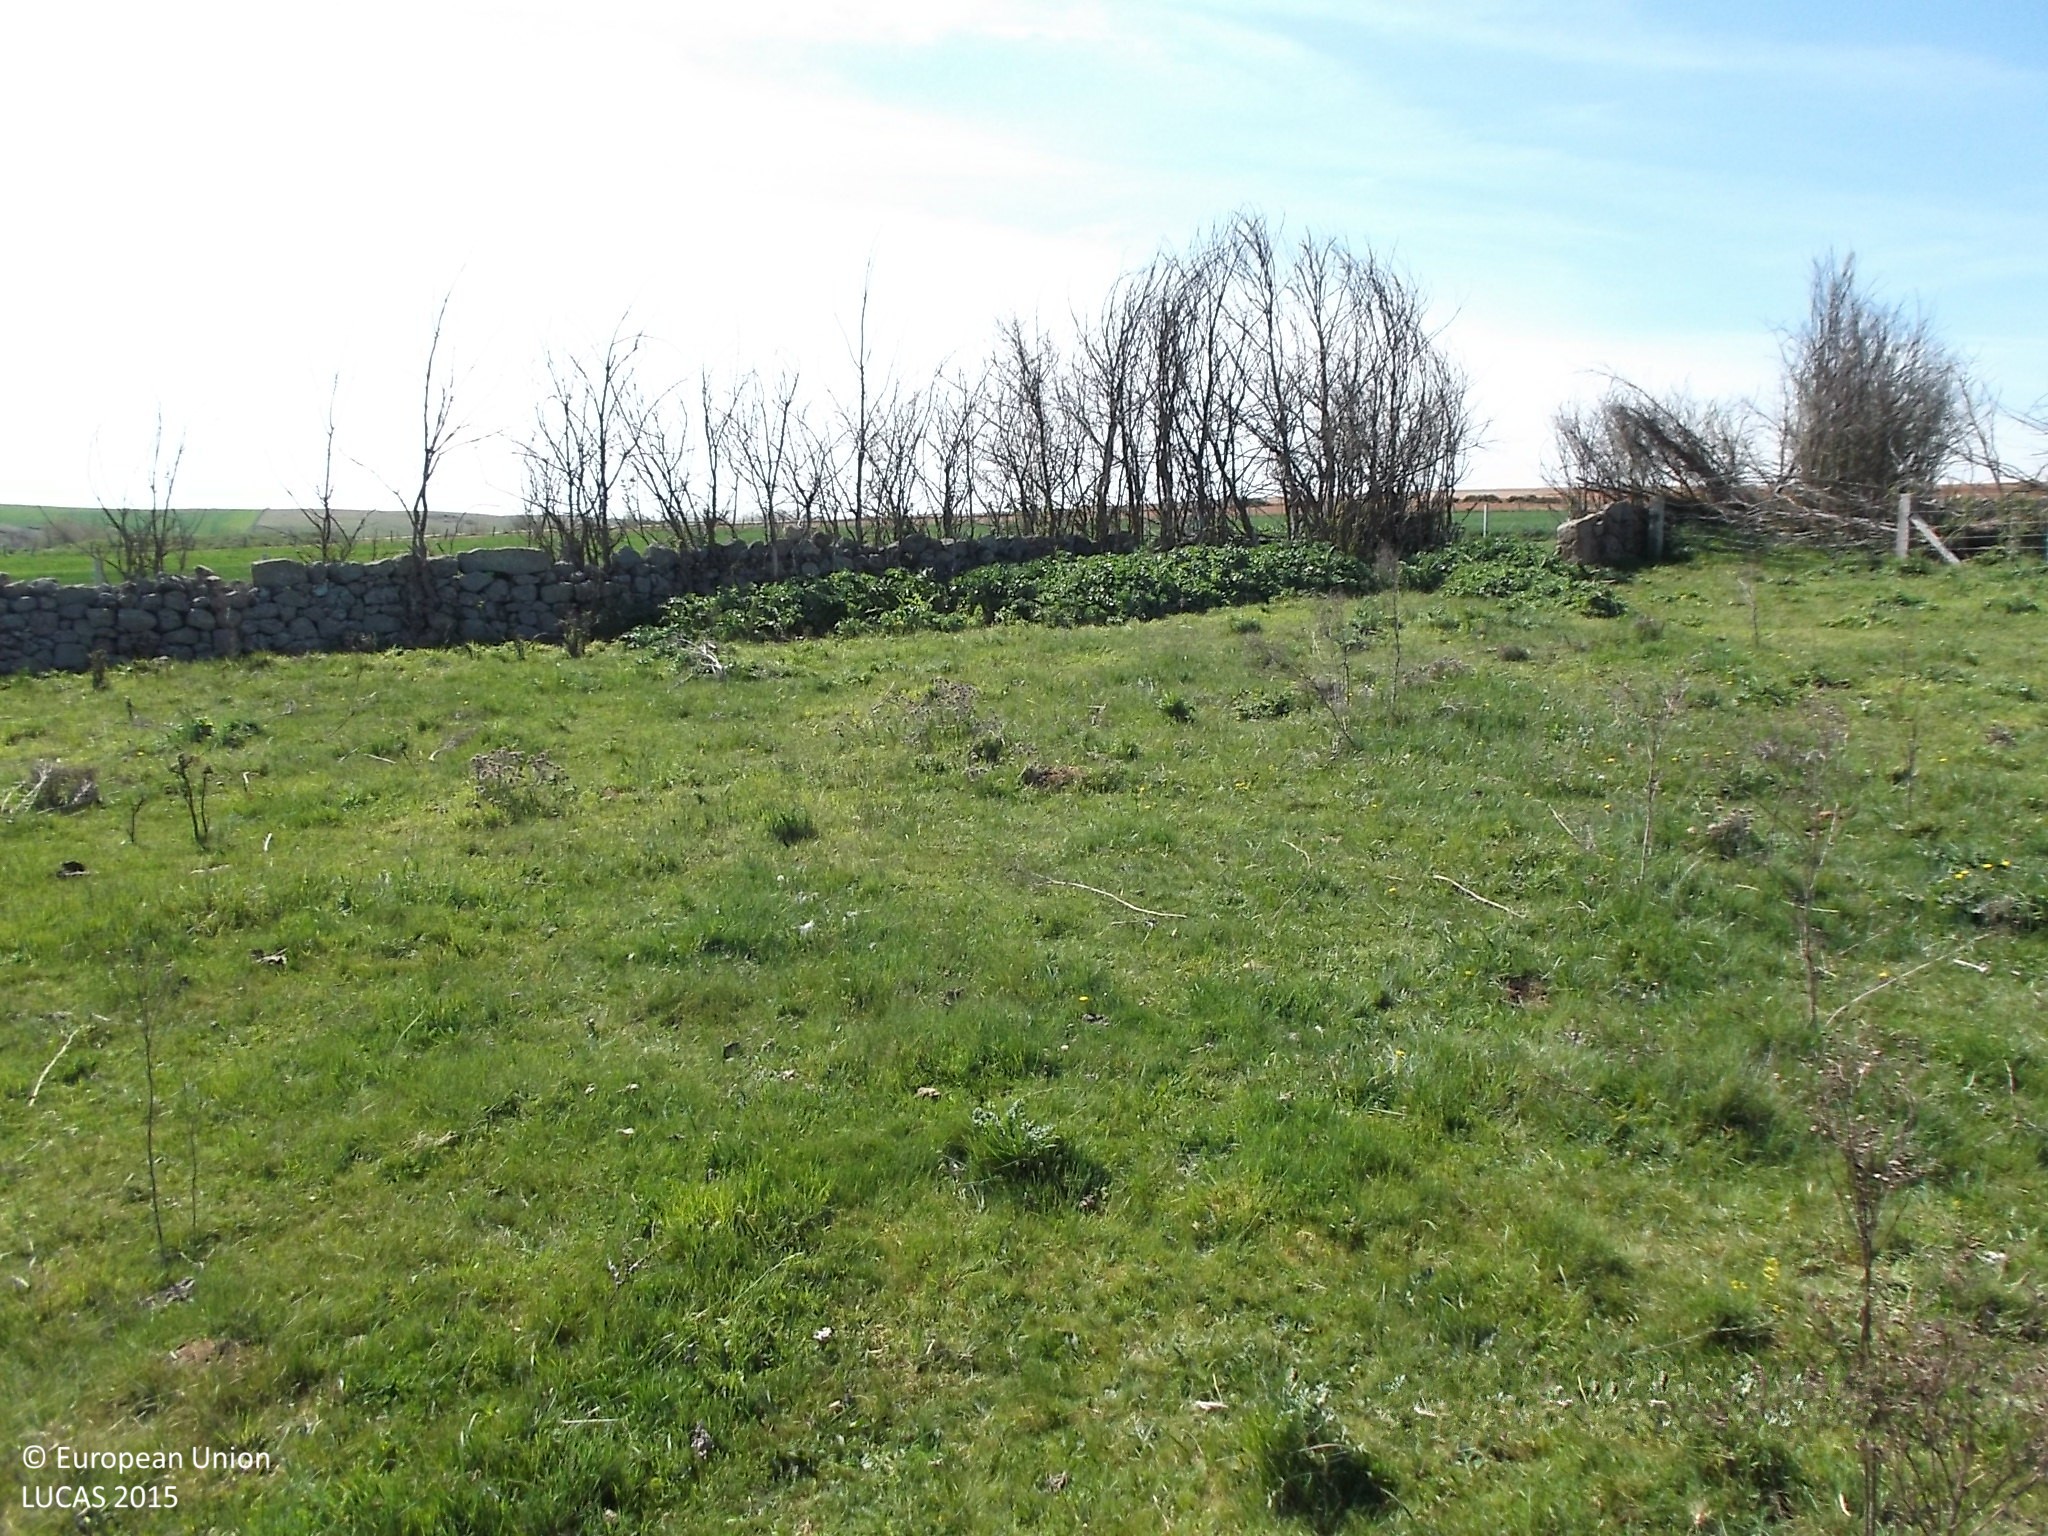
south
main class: Grassland
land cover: Grassland without tree/shrub cover
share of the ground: > 75 %
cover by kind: herbaceous plants 100 %
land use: Agriculture (excluding fallow land and kitchen gardens)
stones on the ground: < 10 %
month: April
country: ES
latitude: 40.9664
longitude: -5.8975
